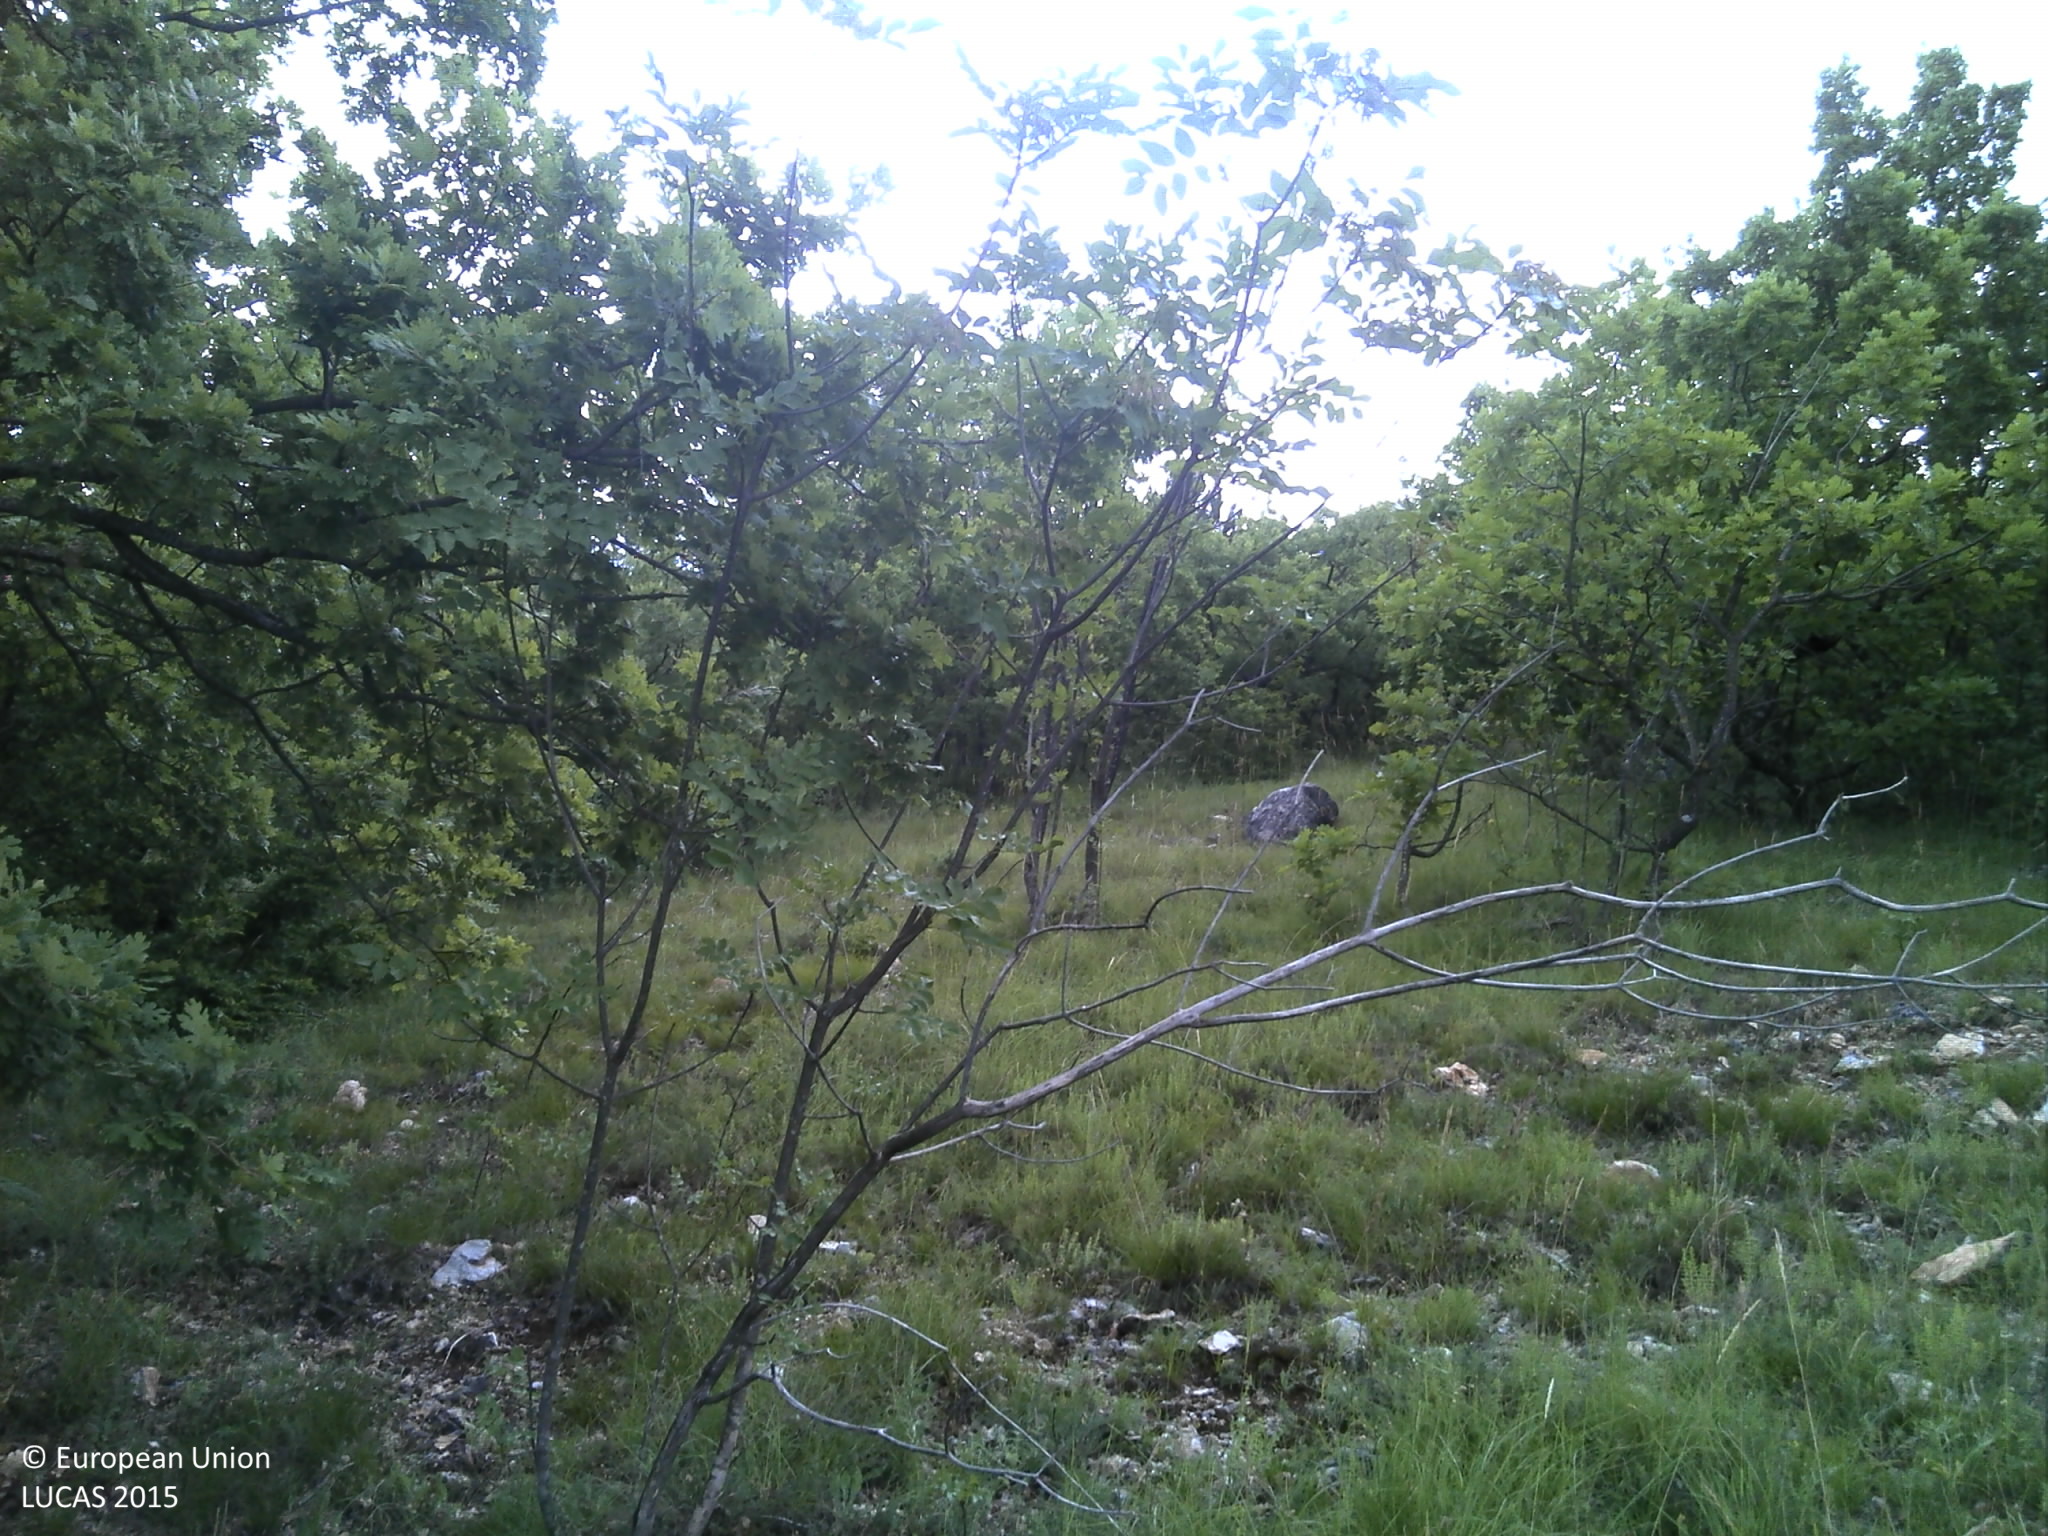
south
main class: Woodland
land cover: Broadleaved woodland
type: thermophilous deciduous forest
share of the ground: 50 - 75 %
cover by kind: broadleaved forest trees 65 %, herbaceous plants 15 %, coniferous forest trees 10 %, consolidated bare surface 10 %
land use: Semi-natural and natural areas not in use
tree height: > 5 m
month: June
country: HR
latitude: 43.5846
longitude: 16.5180
